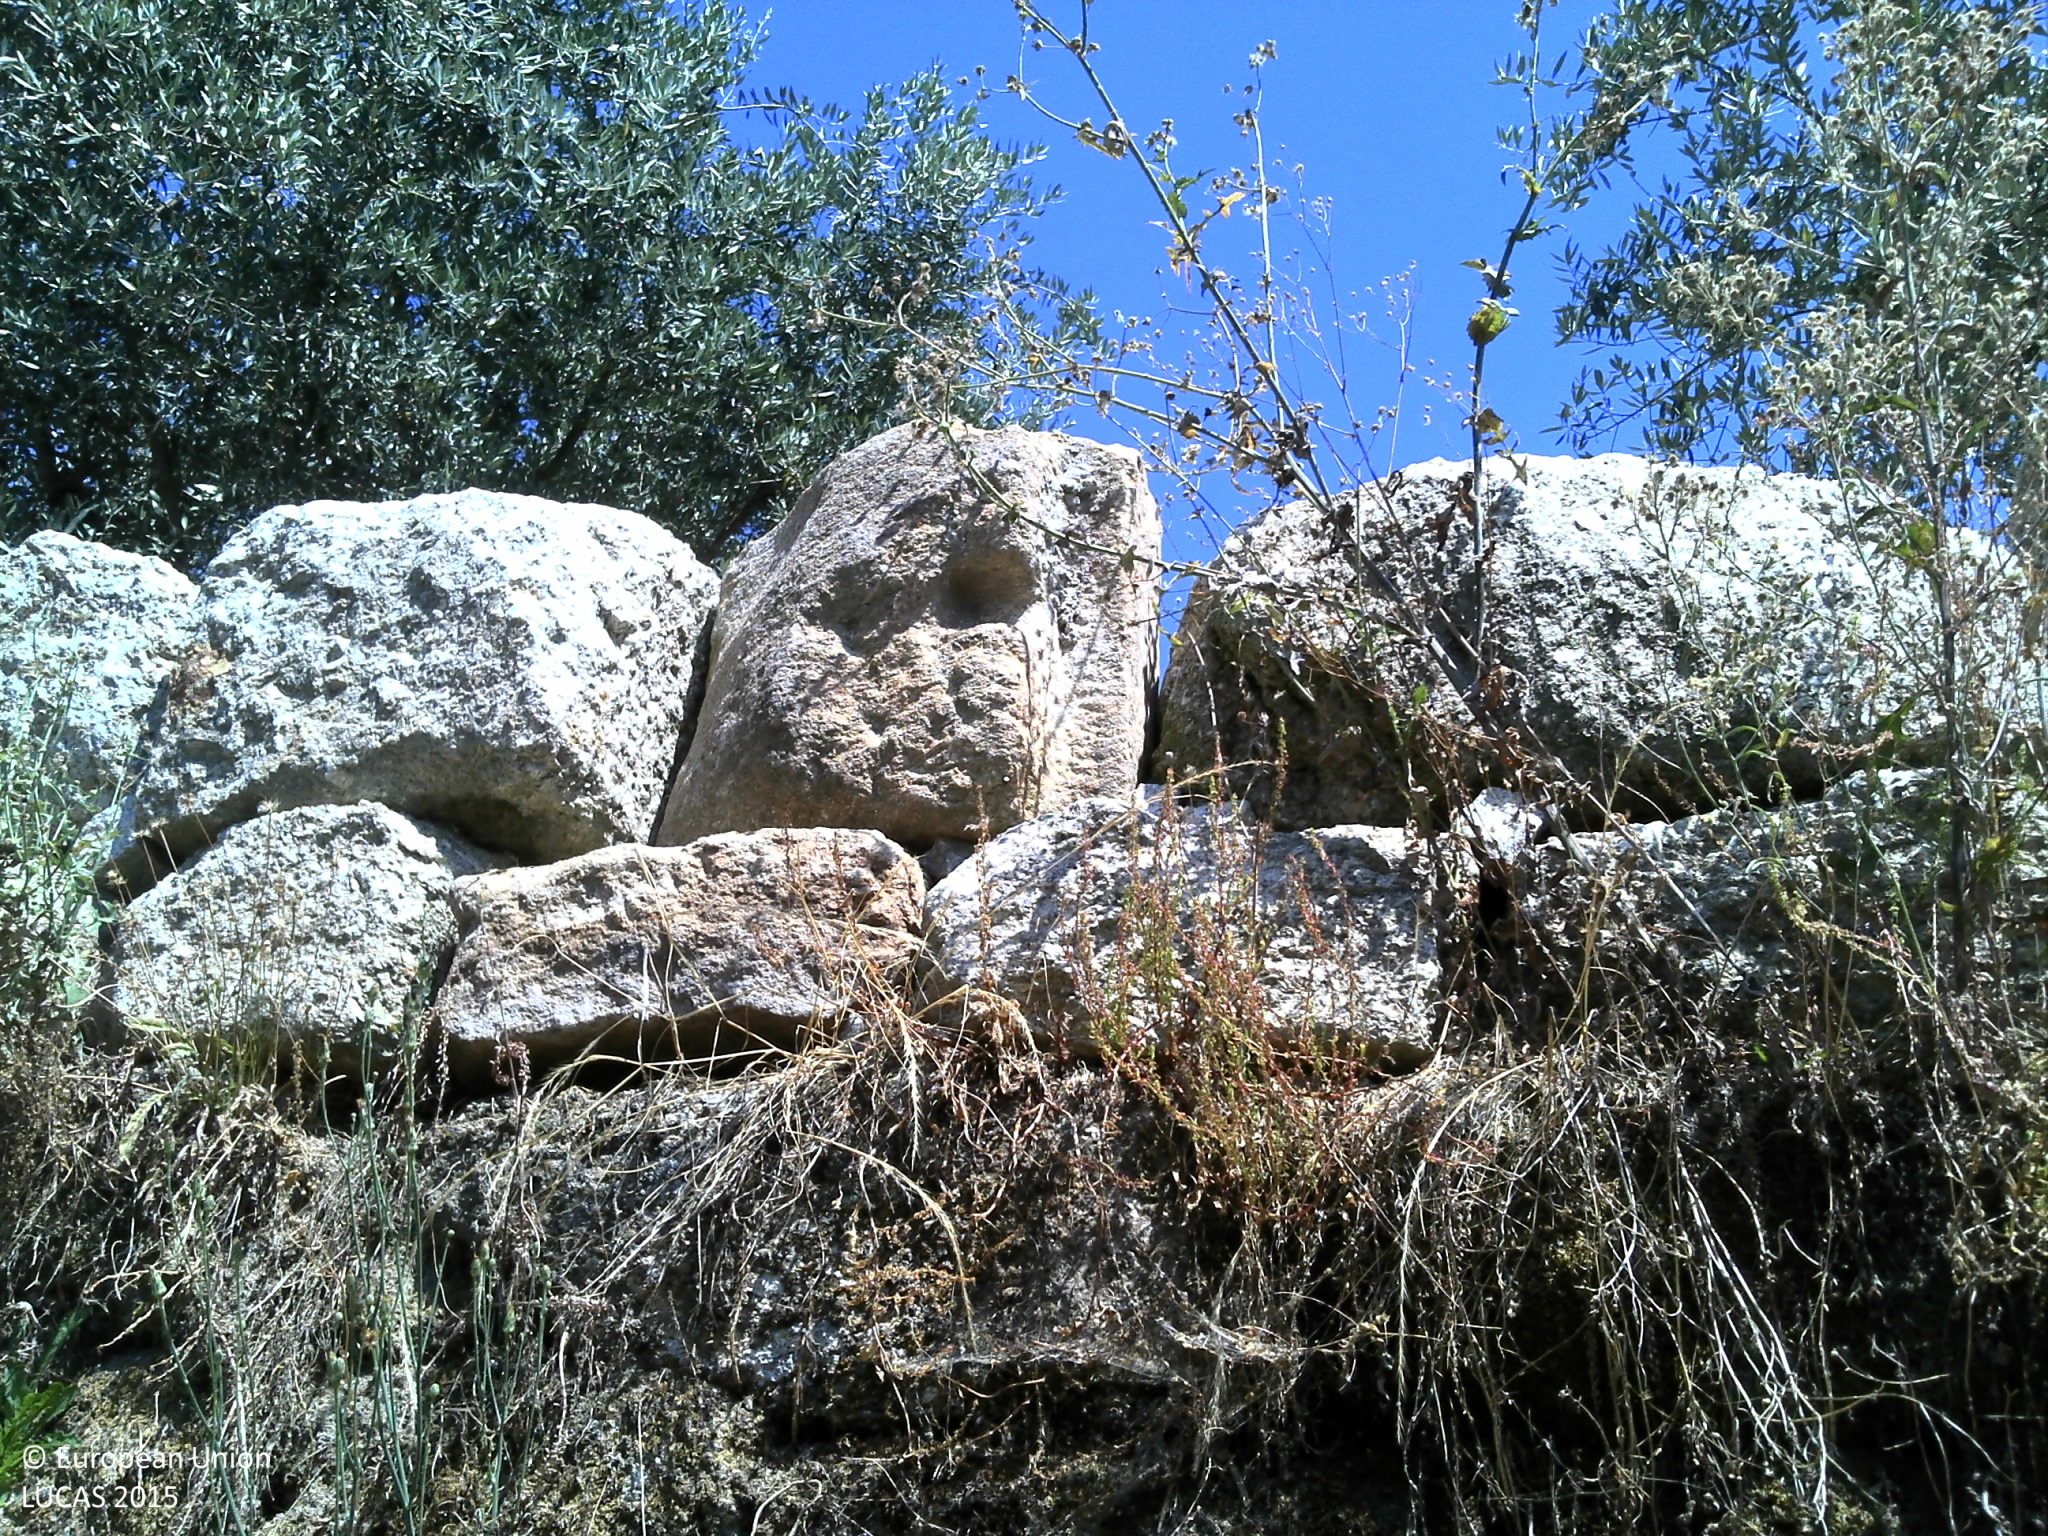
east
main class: Cropland
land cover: Olive groves
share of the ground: 10 - 25 %
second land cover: Other fresh vegetables
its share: 25 - 50 %
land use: Agriculture (excluding fallow land and kitchen gardens)
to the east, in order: Olive groves; Other fresh vegetables; Dry stone walls; Olive groves; Dry stone walls; Pine dominated mixed woodland; Tracks; Pine dominated mixed woodland; Tracks; Pine dominated mixed woodland; Artificial constructions in urban areas
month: July
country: PT
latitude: 40.7369
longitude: -7.5590
